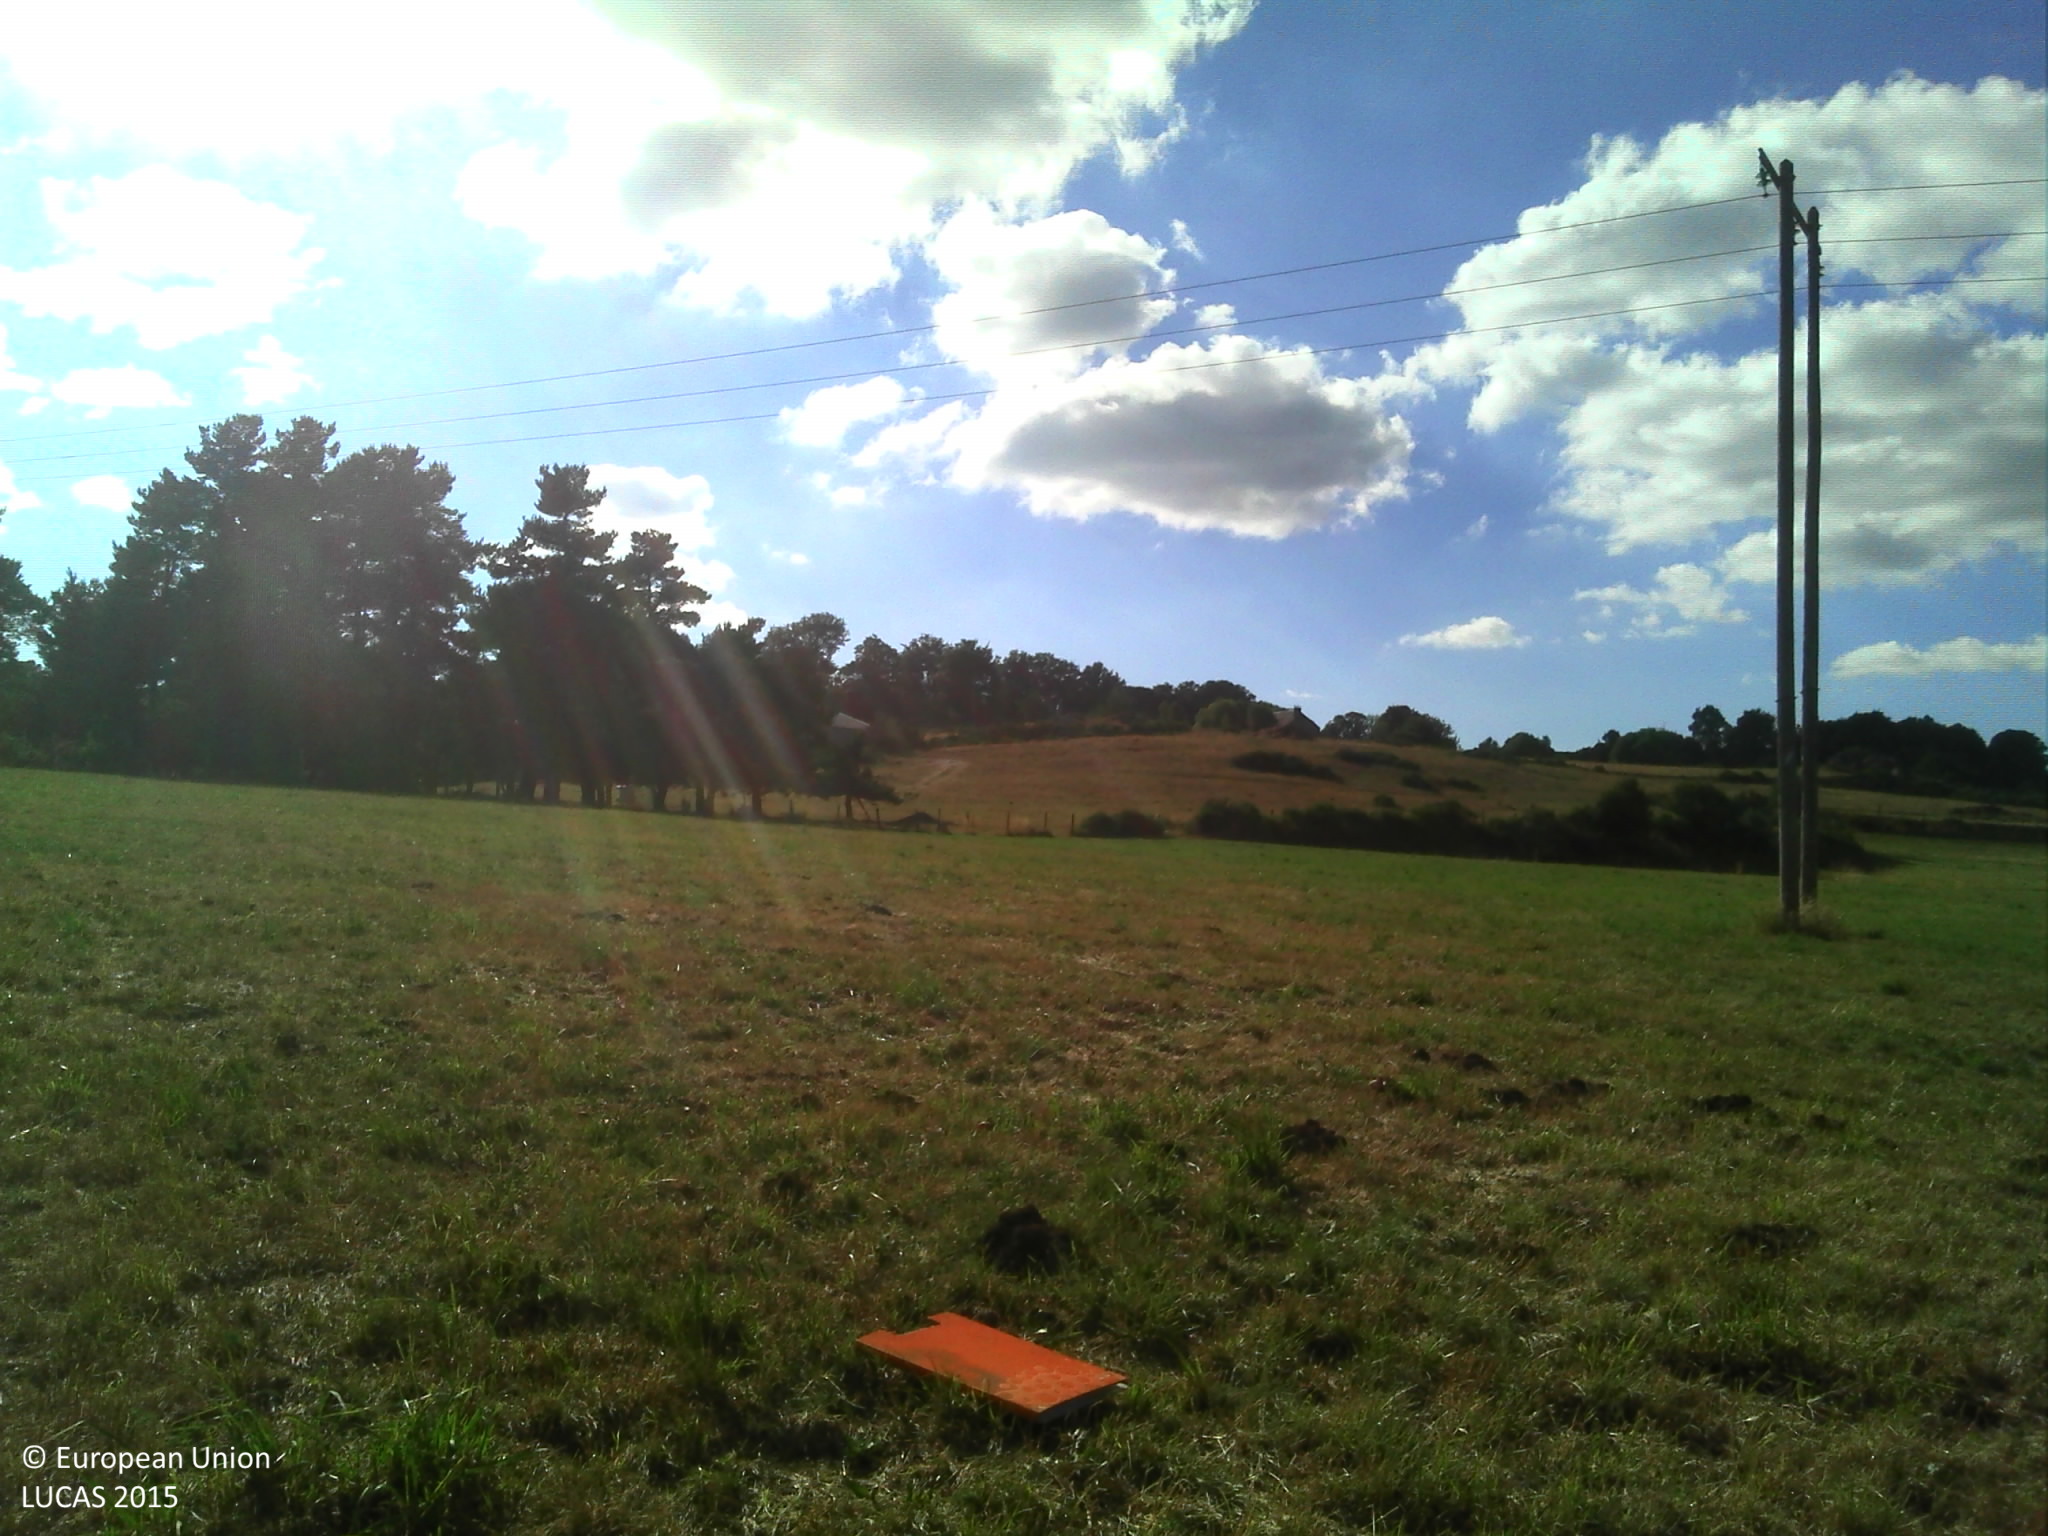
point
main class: Grassland
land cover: Grassland without tree/shrub cover
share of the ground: > 75 %
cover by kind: herbaceous plants 100 %
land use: Agriculture (excluding fallow land and kitchen gardens)
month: July
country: FR
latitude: 44.7227
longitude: 3.1735
